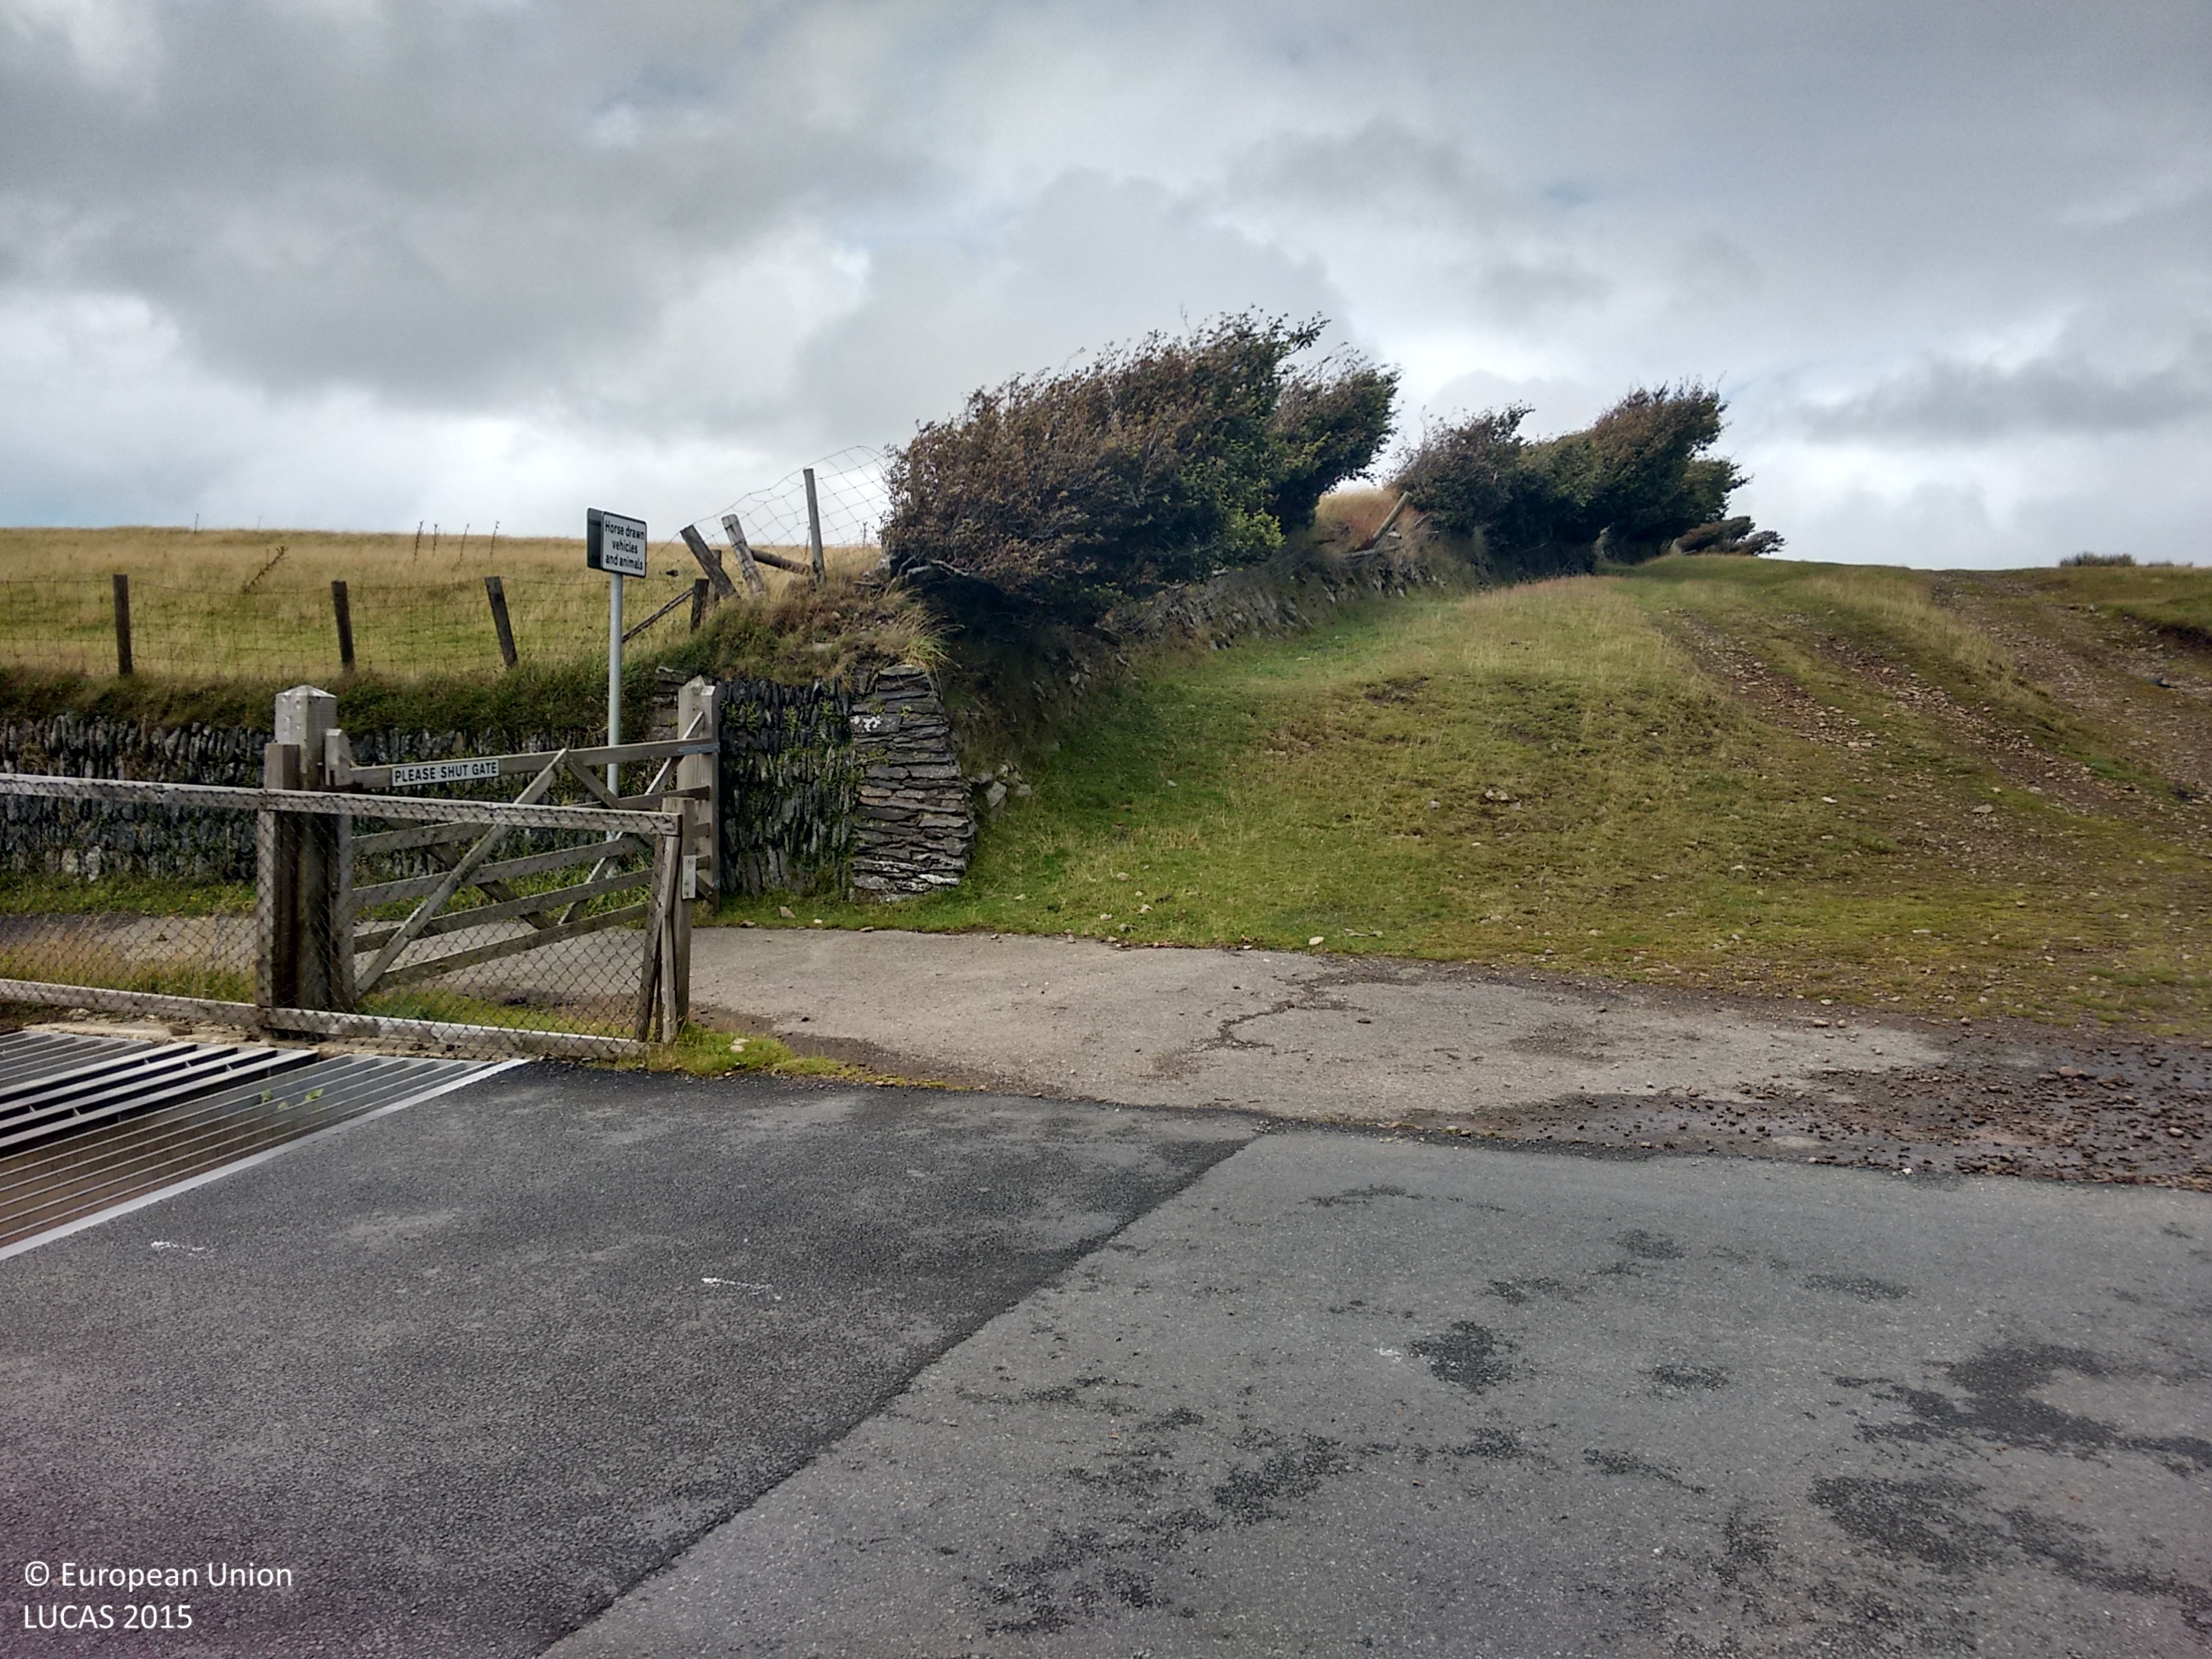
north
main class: Grassland
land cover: Grassland with sparse tree/shrub cover
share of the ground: > 75 %
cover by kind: herbaceous plants 95 %, broadleaved forest trees 5 %
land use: Agriculture (excluding fallow land and kitchen gardens)
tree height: < 5 m
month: August
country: GB
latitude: 51.2028
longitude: -3.7870
